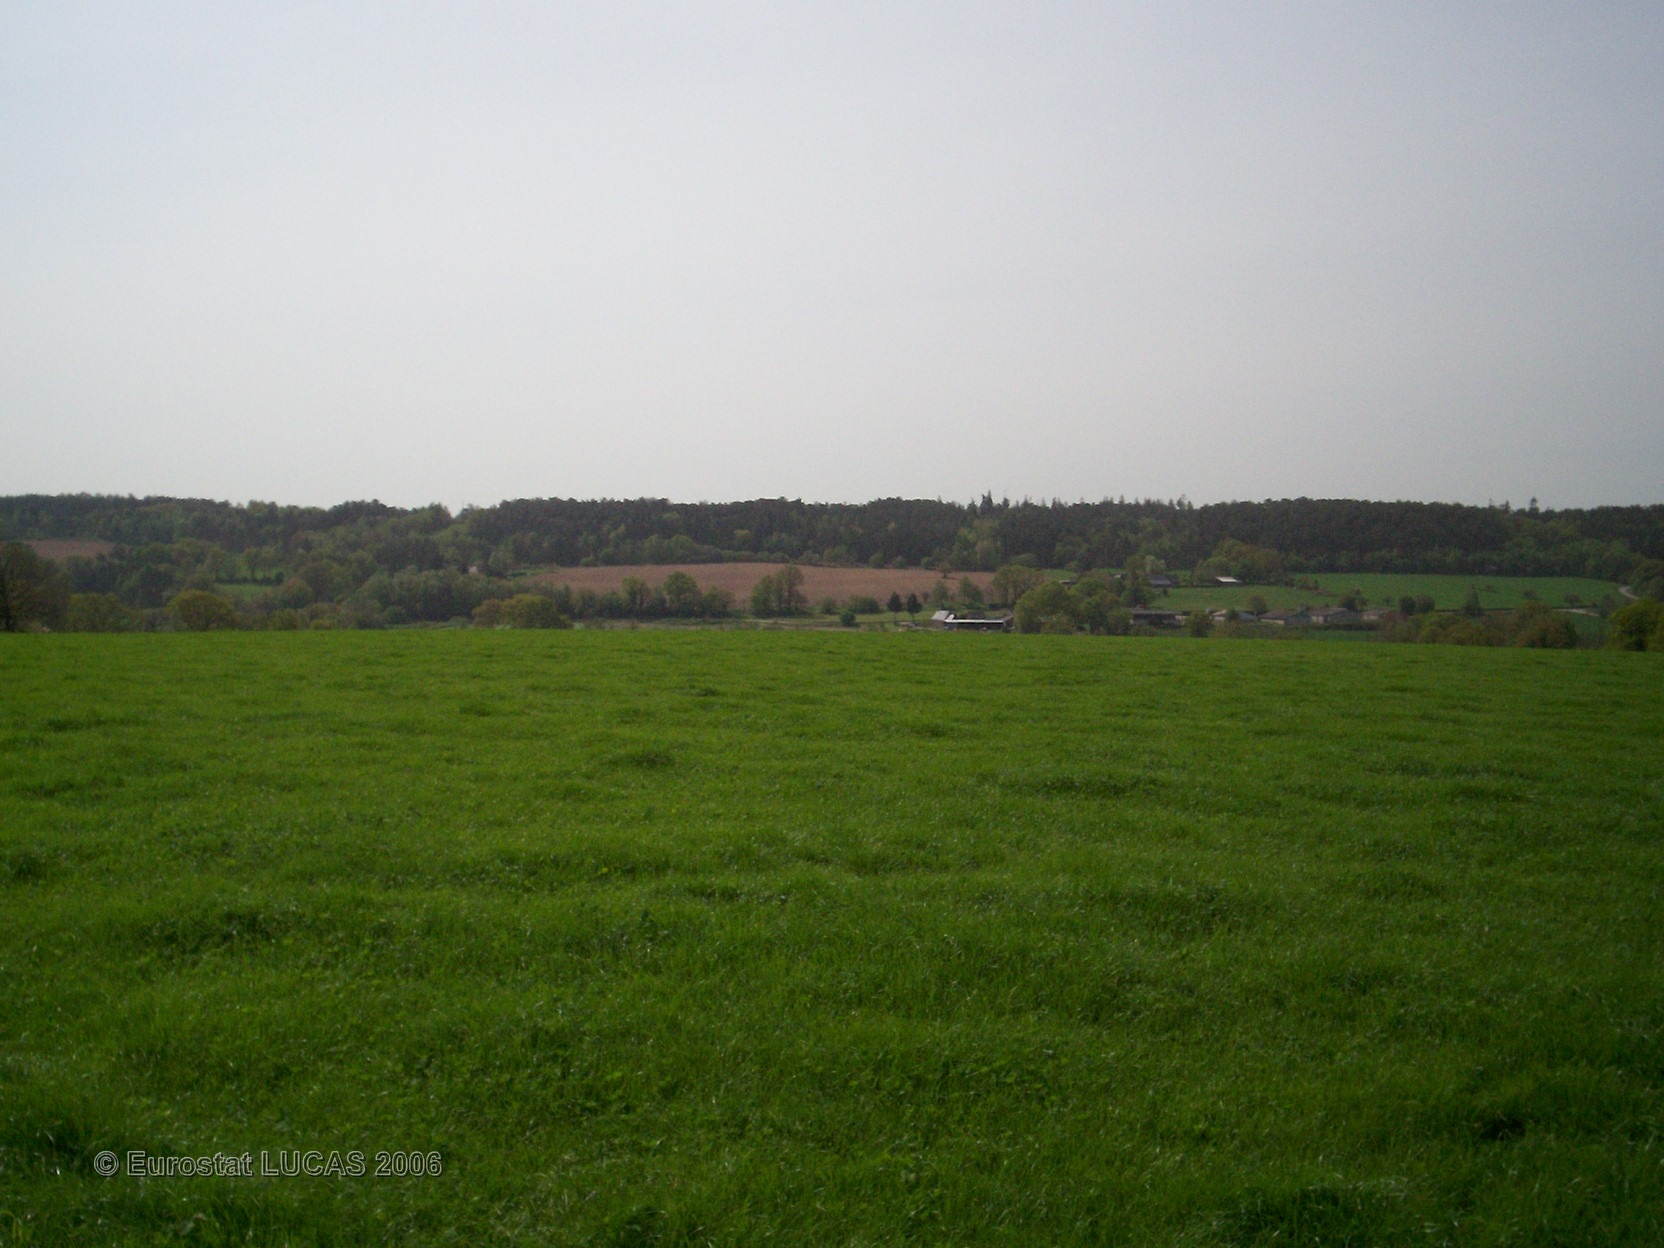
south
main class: Grassland
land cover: Grassland without tree/shrub cover
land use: Agriculture (excluding fallow land and kitchen gardens)
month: May
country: FR
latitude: 47.7132
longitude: -2.3046
